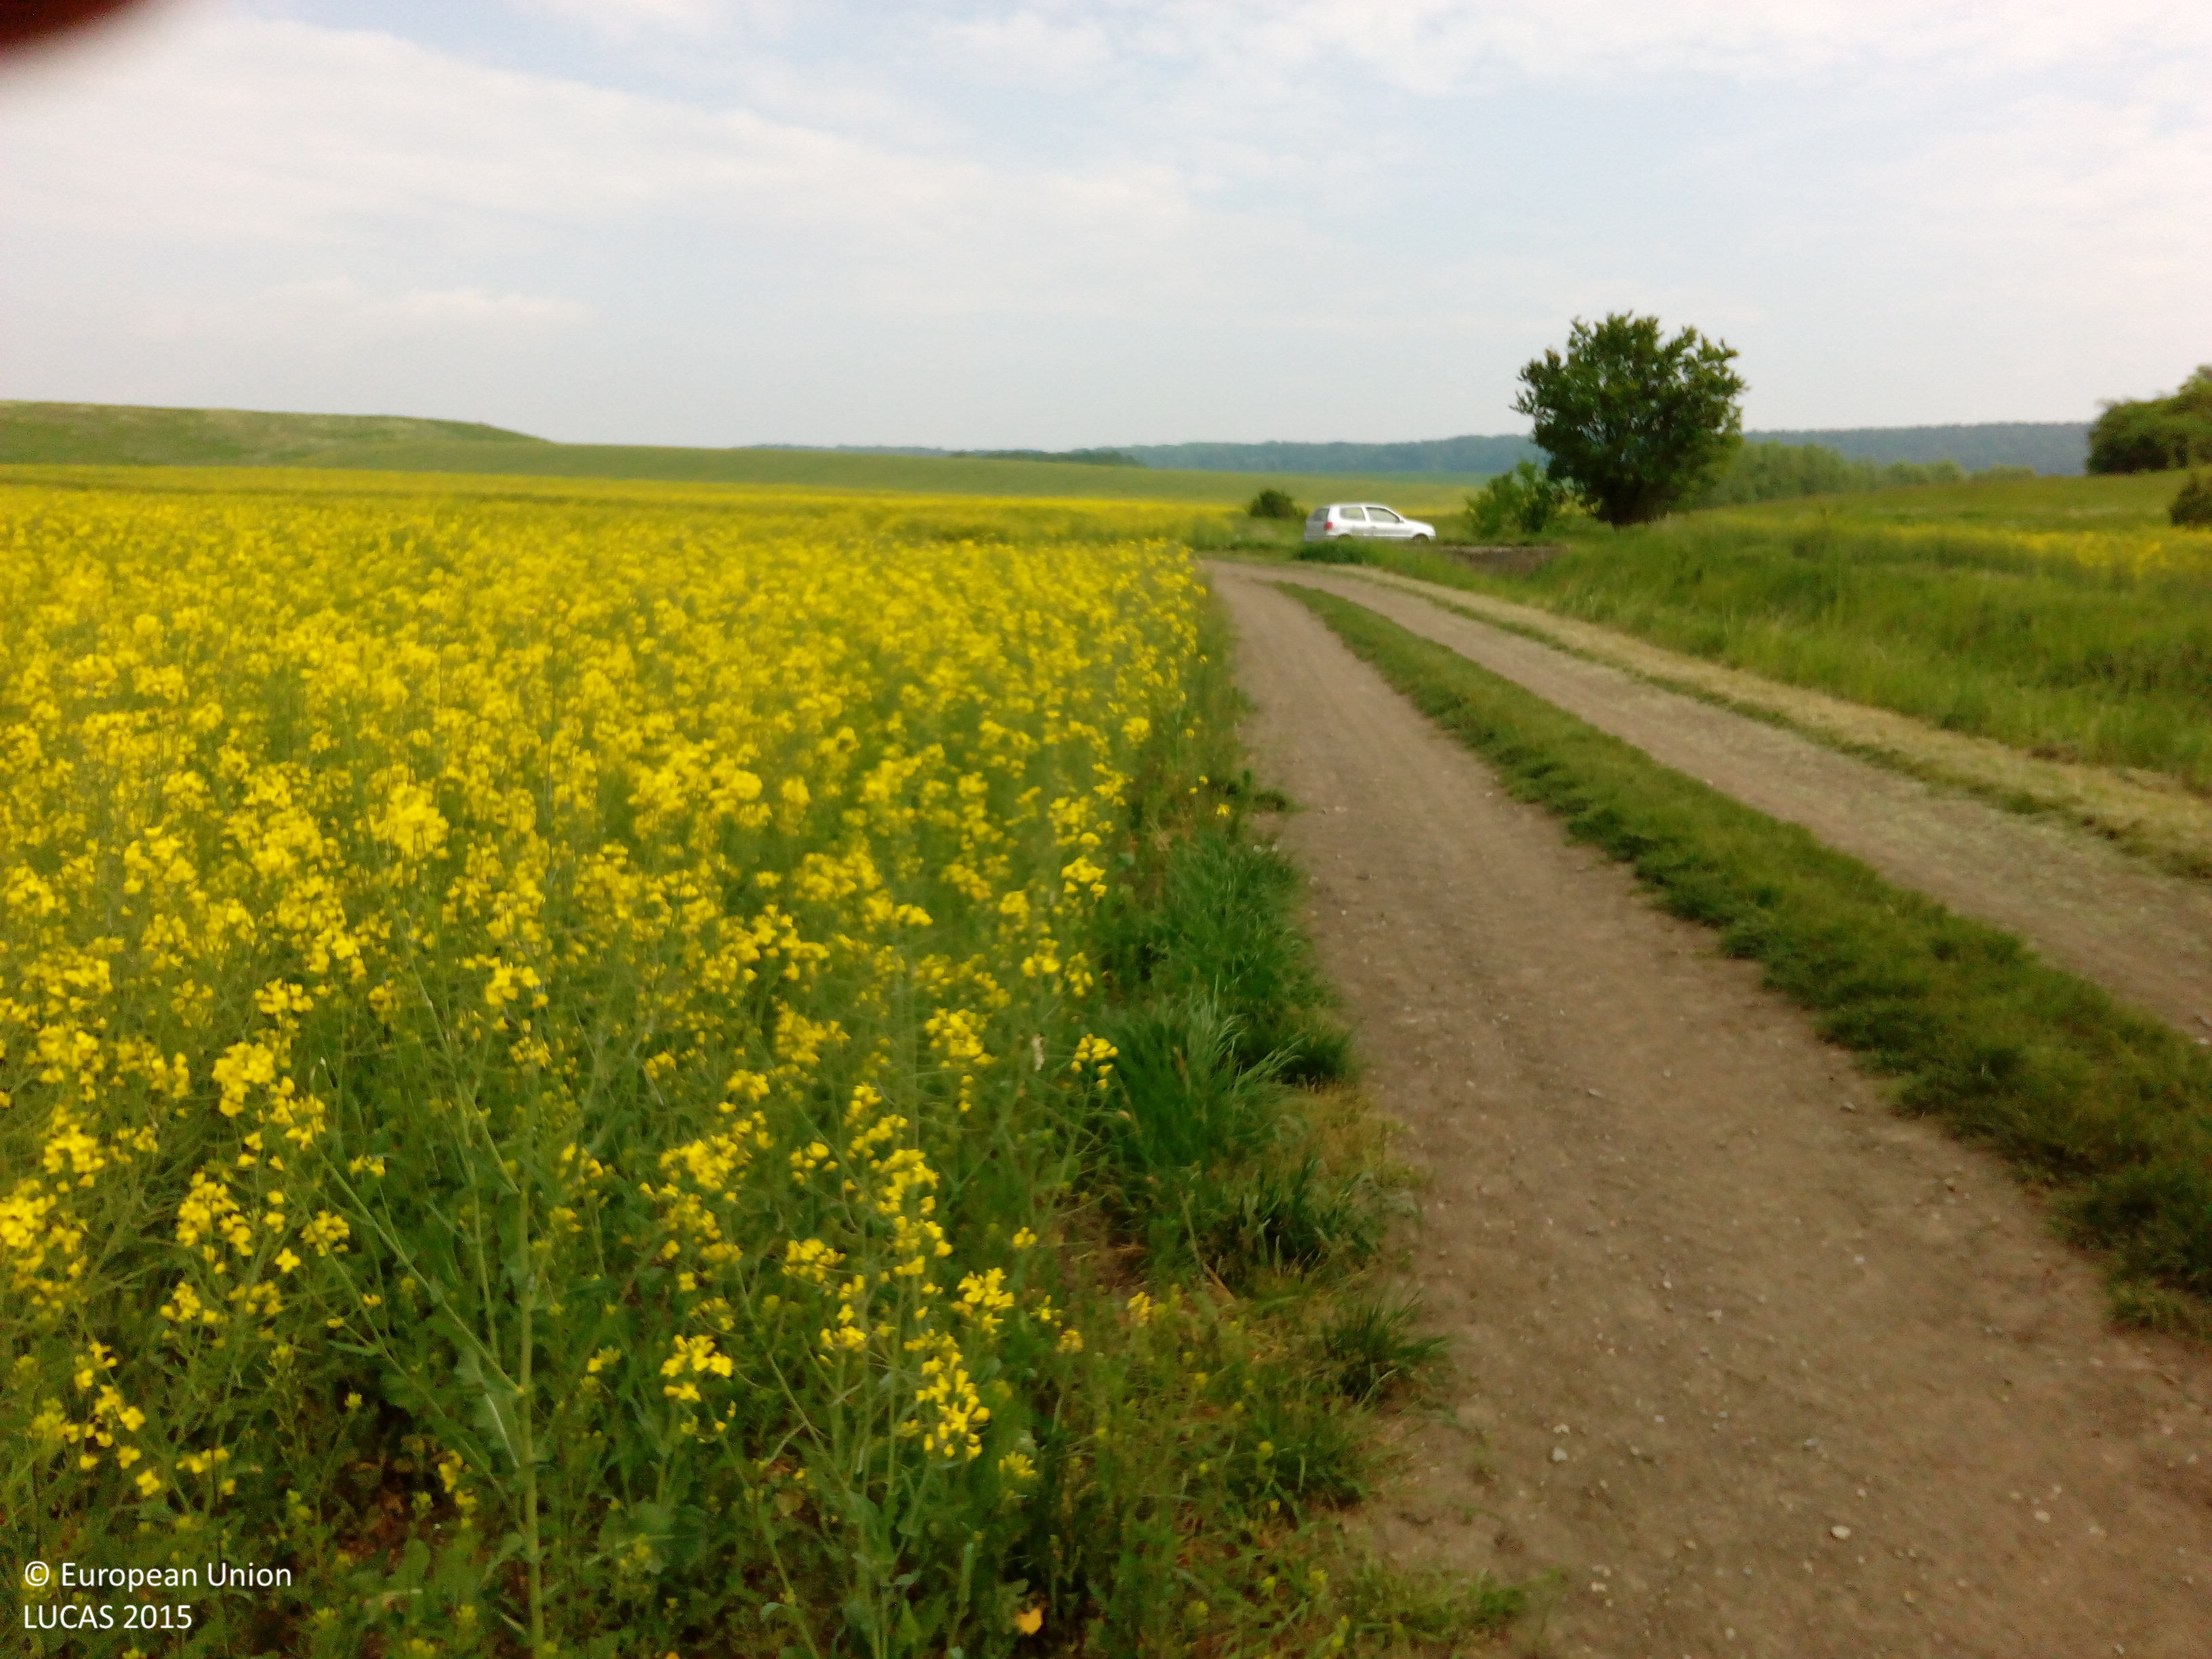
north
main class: Cropland
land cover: Rape and turnip rape
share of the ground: > 75 %
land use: Agriculture (excluding fallow land and kitchen gardens)
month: May
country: DE
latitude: 51.1275
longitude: 11.5000
